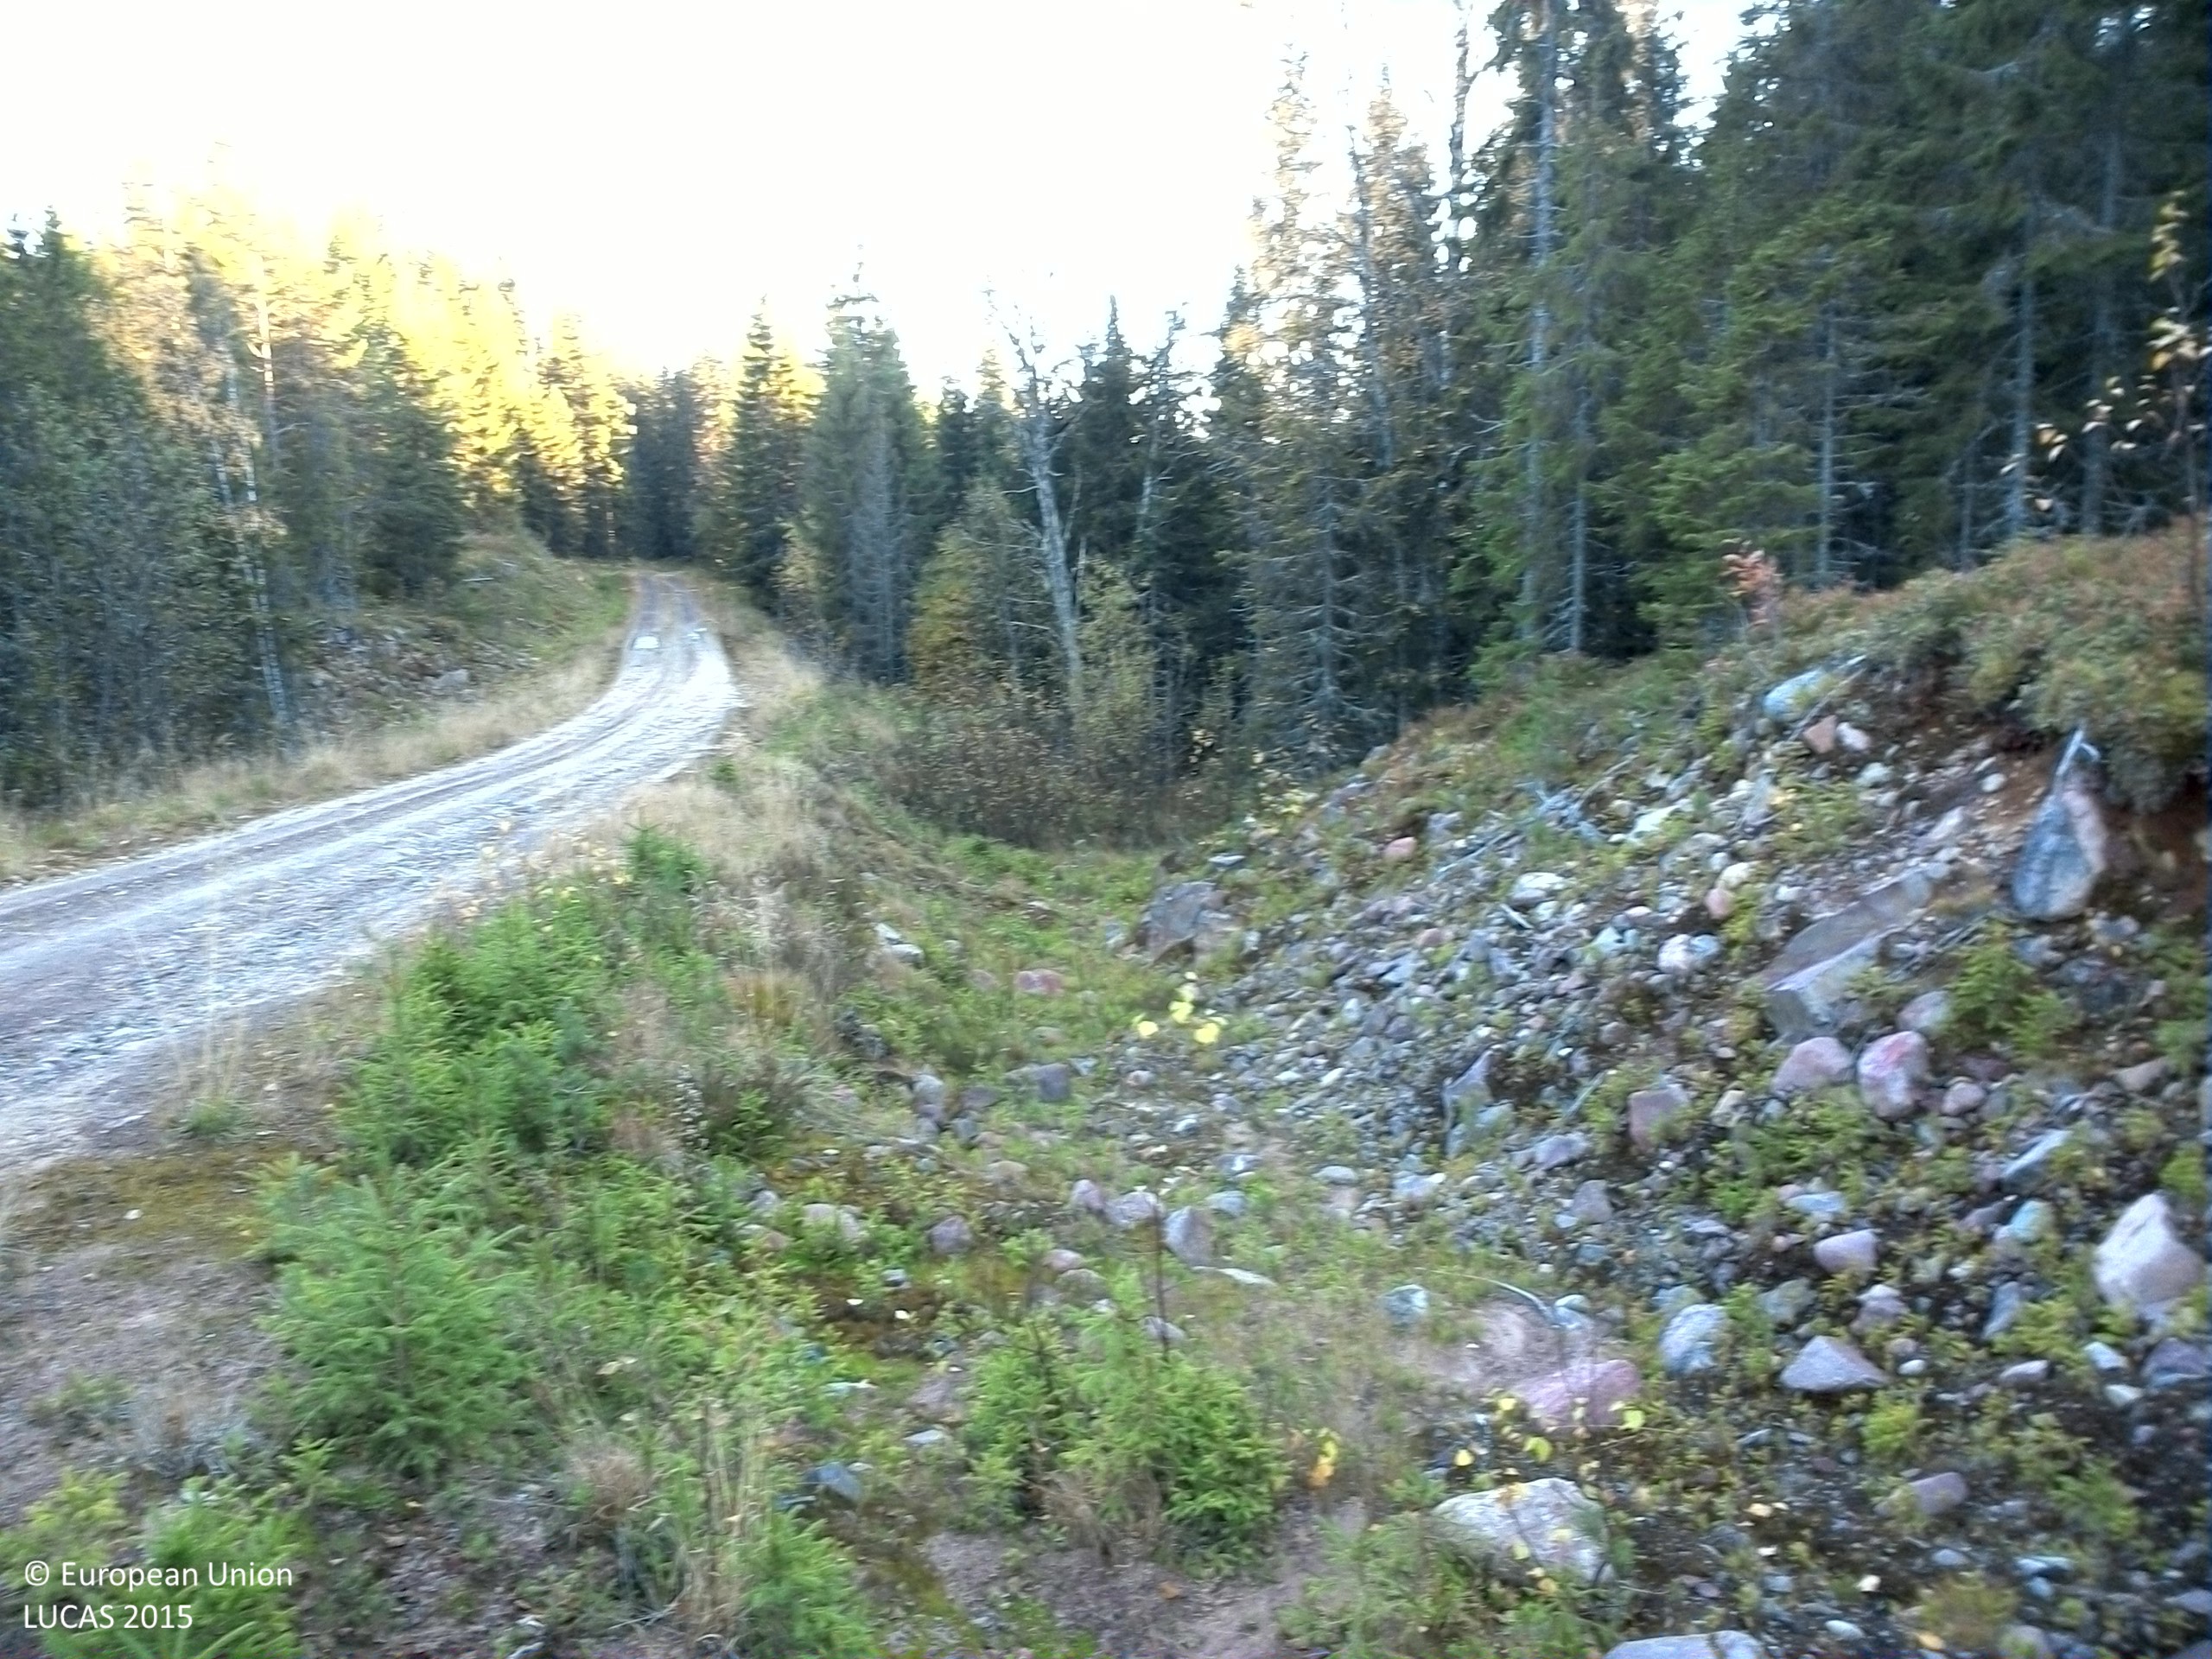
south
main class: Woodland
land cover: Spruce dominated mixed woodland
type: boreal forest
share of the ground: 25 - 50 %
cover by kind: shrubs 30 %, coniferous forest trees 25 %, consolidated bare surface 25 %, broadleaved forest trees 10 %, herbaceous plants 10 %
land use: Road transport
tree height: < 5 m
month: October
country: SE
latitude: 61.2701
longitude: 14.8528
